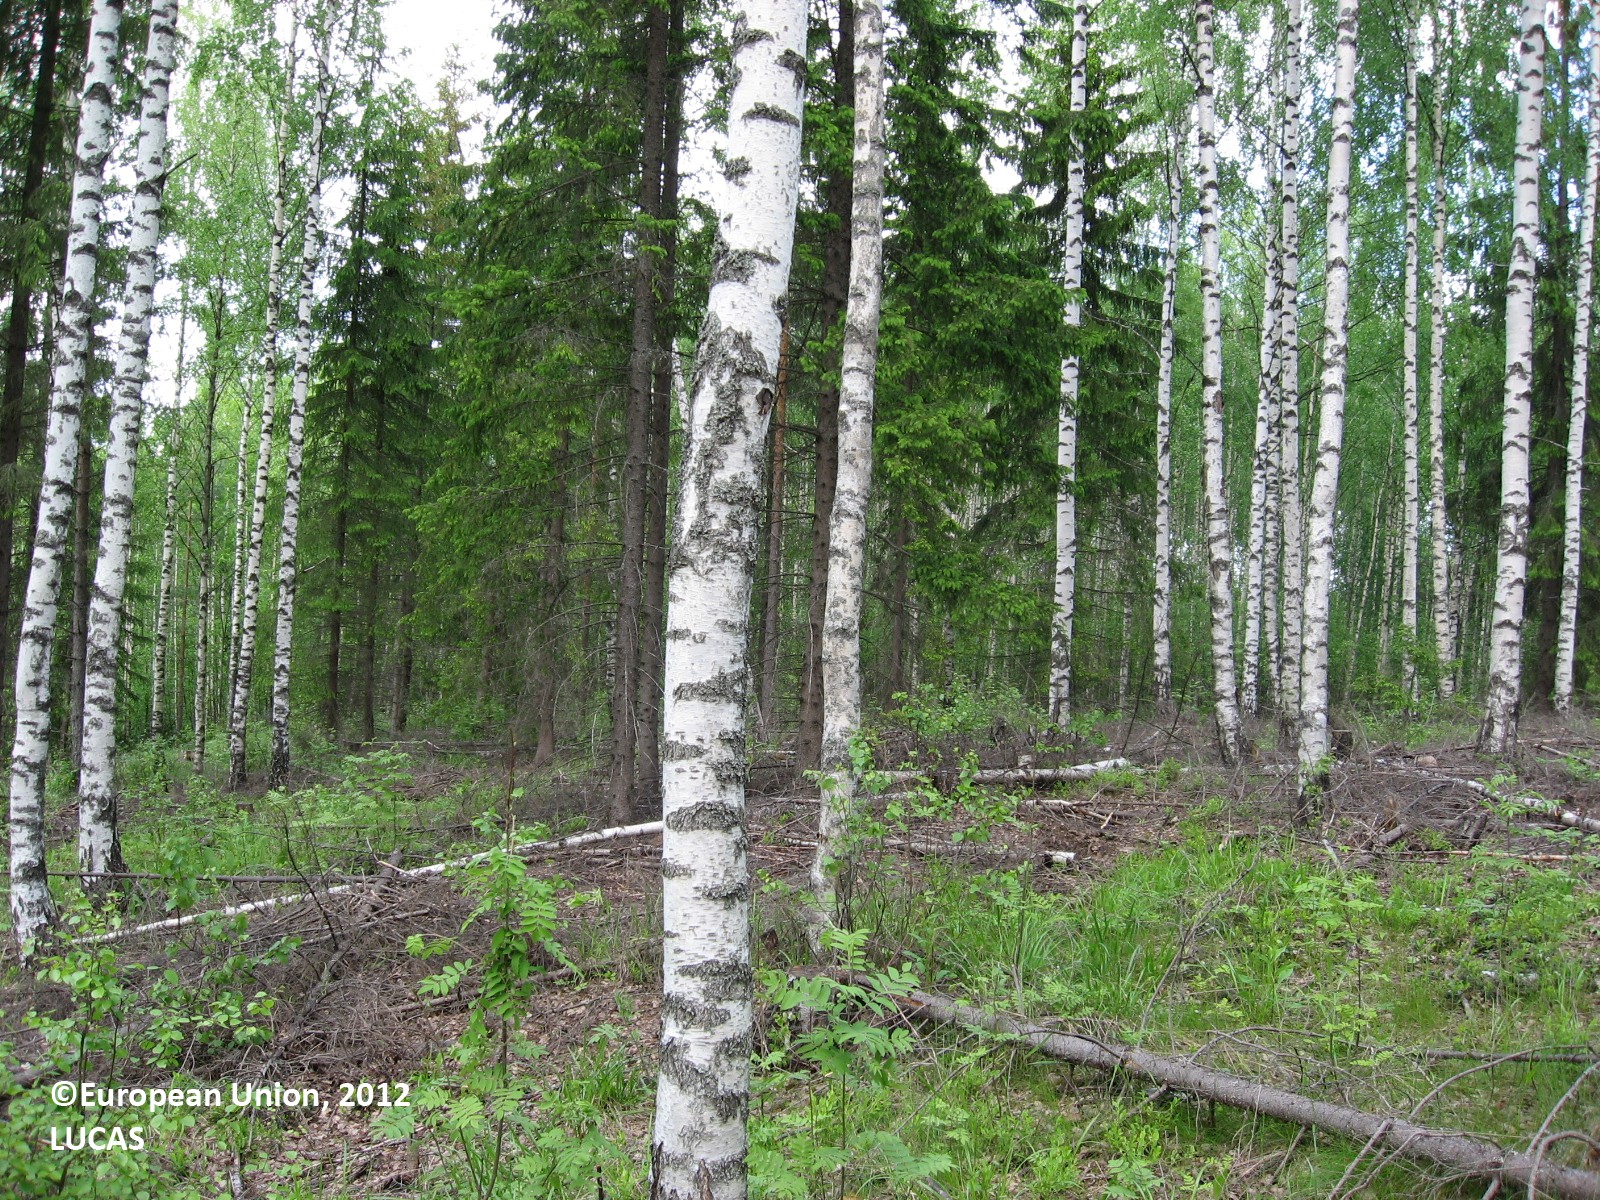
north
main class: Woodland
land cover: Other mixed woodland
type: boreal forest
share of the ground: > 75 %
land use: Forestry
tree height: > 5 m
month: June
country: FI
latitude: 60.4131
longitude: 25.3975
